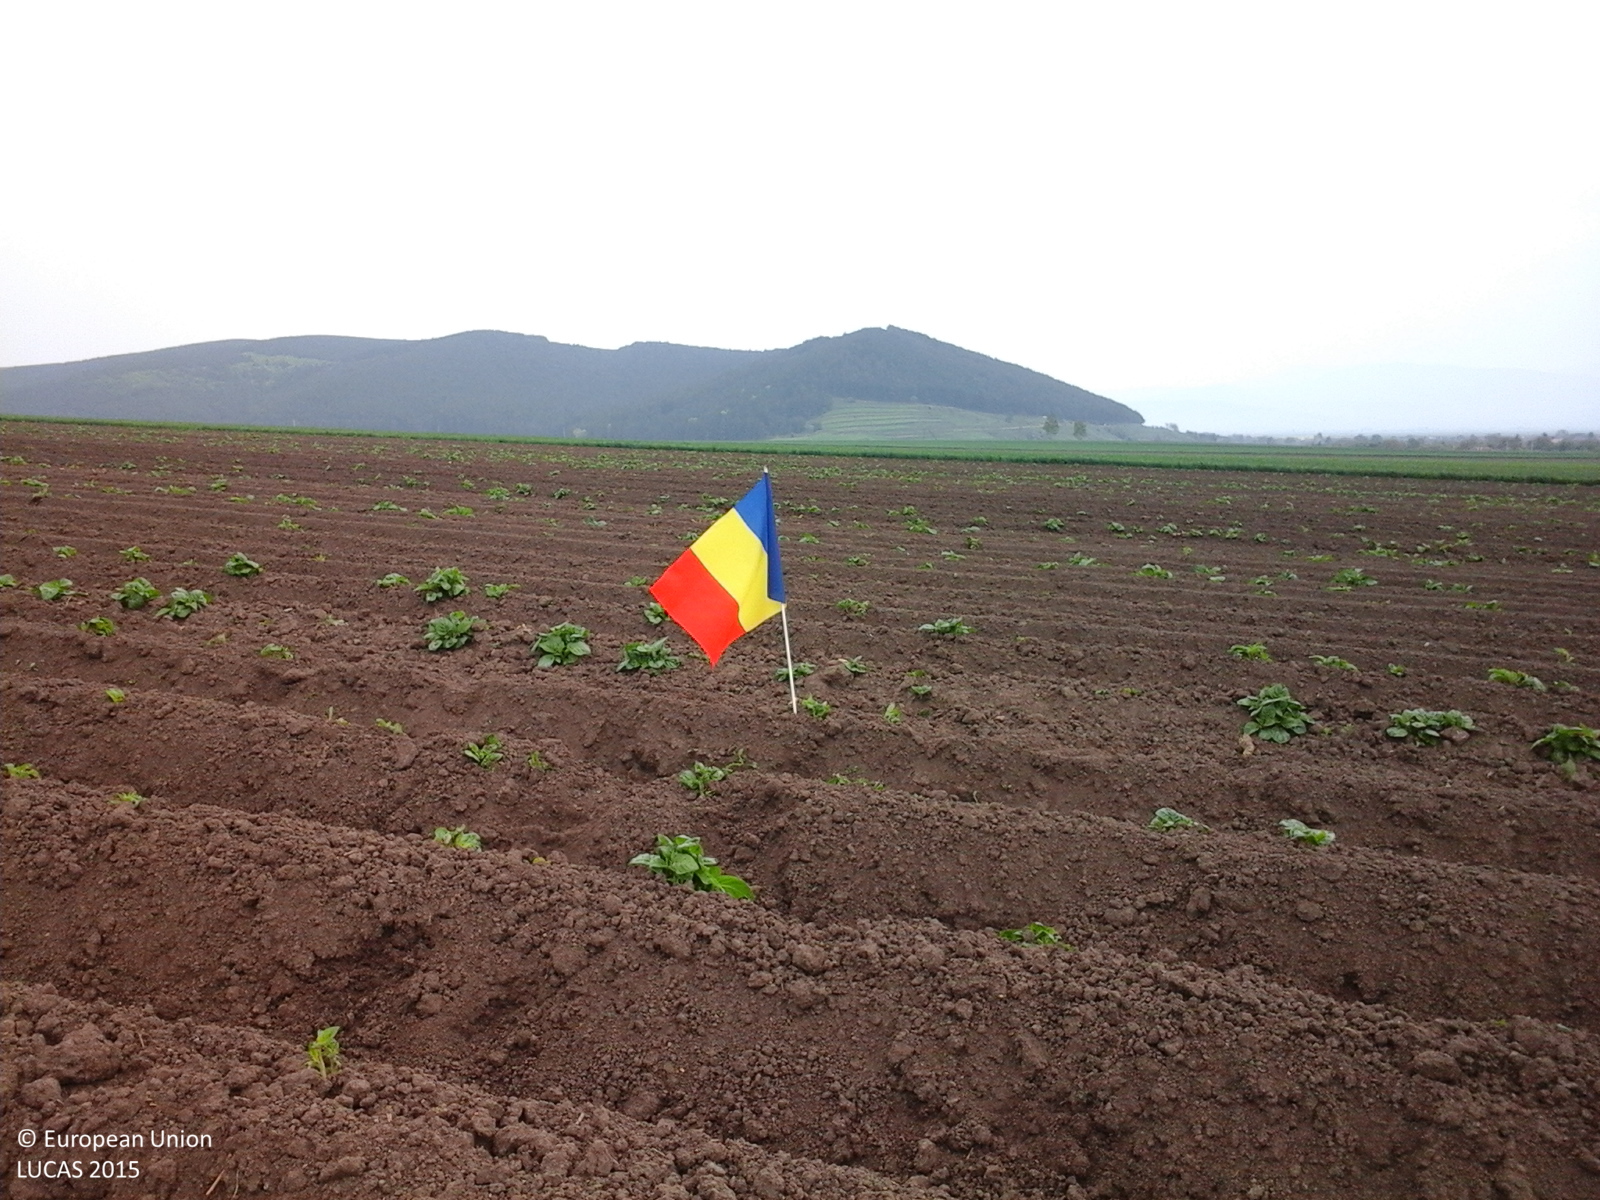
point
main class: Cropland
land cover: Potatoes
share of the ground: < 10 %
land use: Agriculture (excluding fallow land and kitchen gardens)
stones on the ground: < 10 %
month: May
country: RO
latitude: 46.0560
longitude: 26.1090
